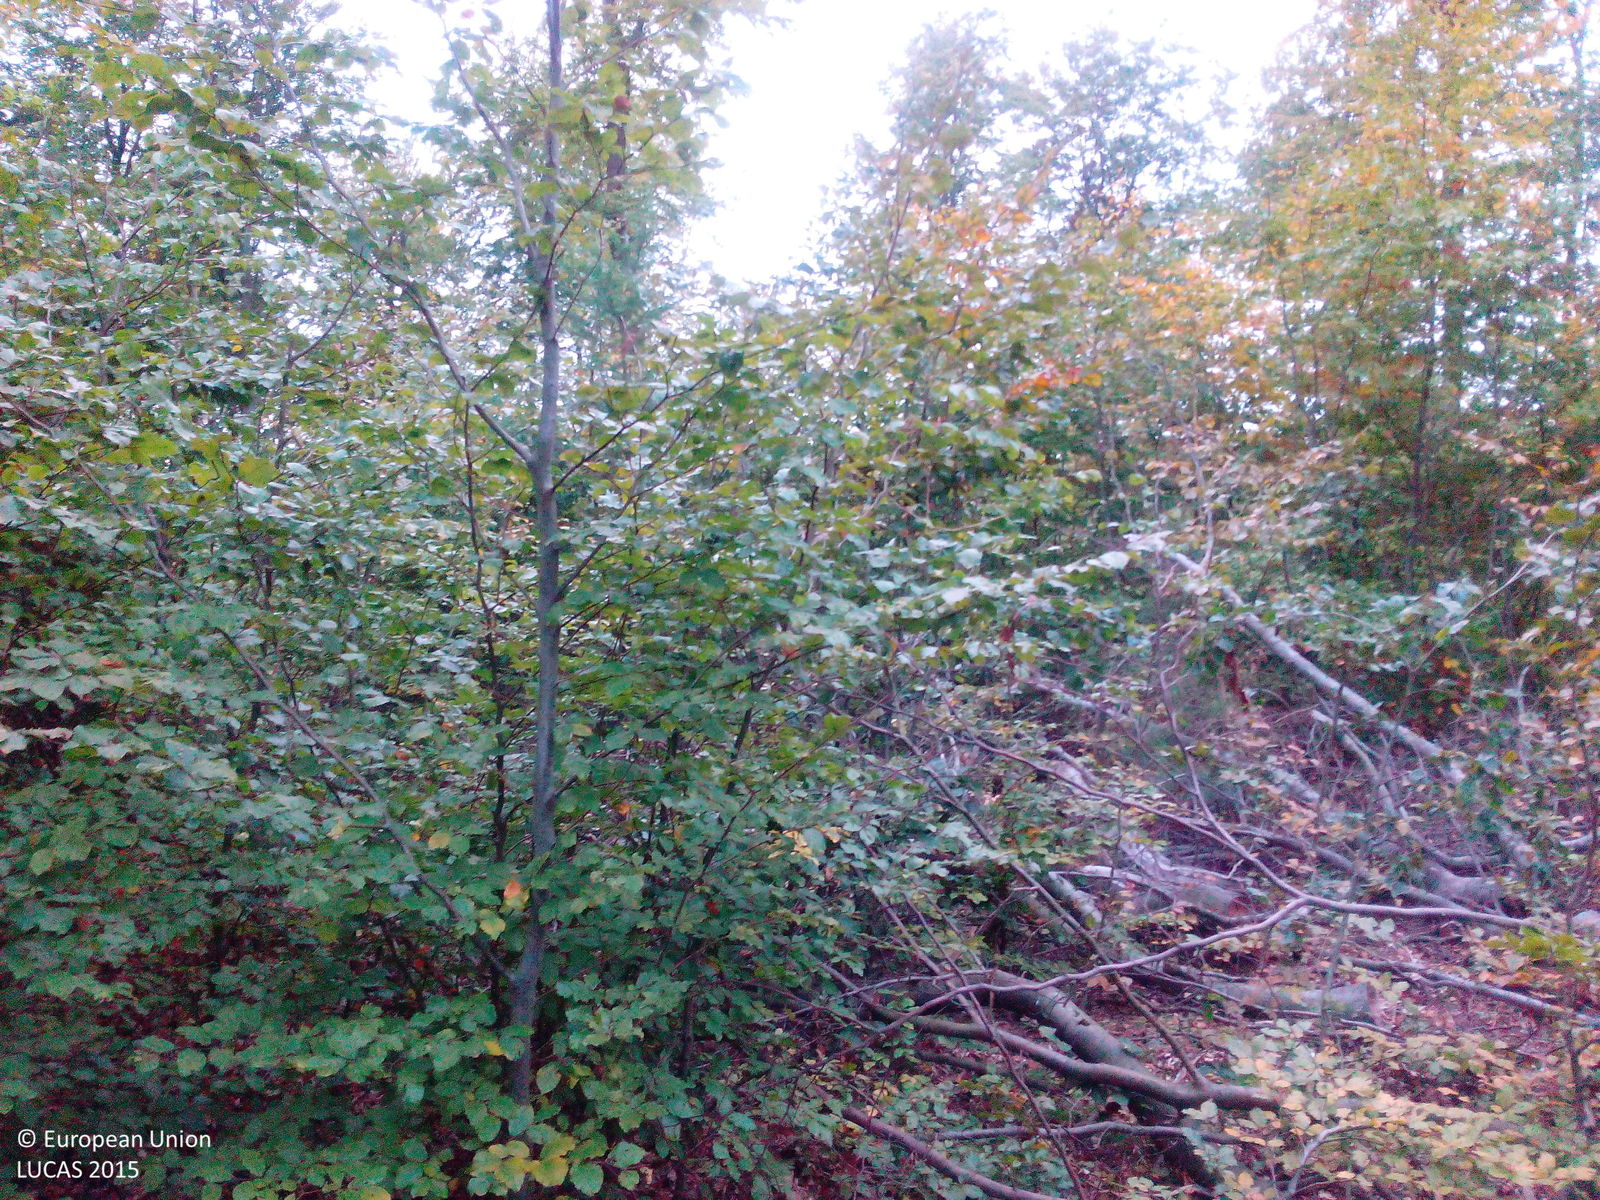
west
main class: Woodland
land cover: Broadleaved woodland
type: mesophytic deciduous forest
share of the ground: 50 - 75 %
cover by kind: broadleaved forest trees 55 %, shrubs 20 %, lichens and mosses 10 %, unconsolidated bare surface 10 %, herbaceous plants 5 %
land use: Forestry
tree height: > 5 m
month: October
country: DE
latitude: 50.1102
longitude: 9.3150
